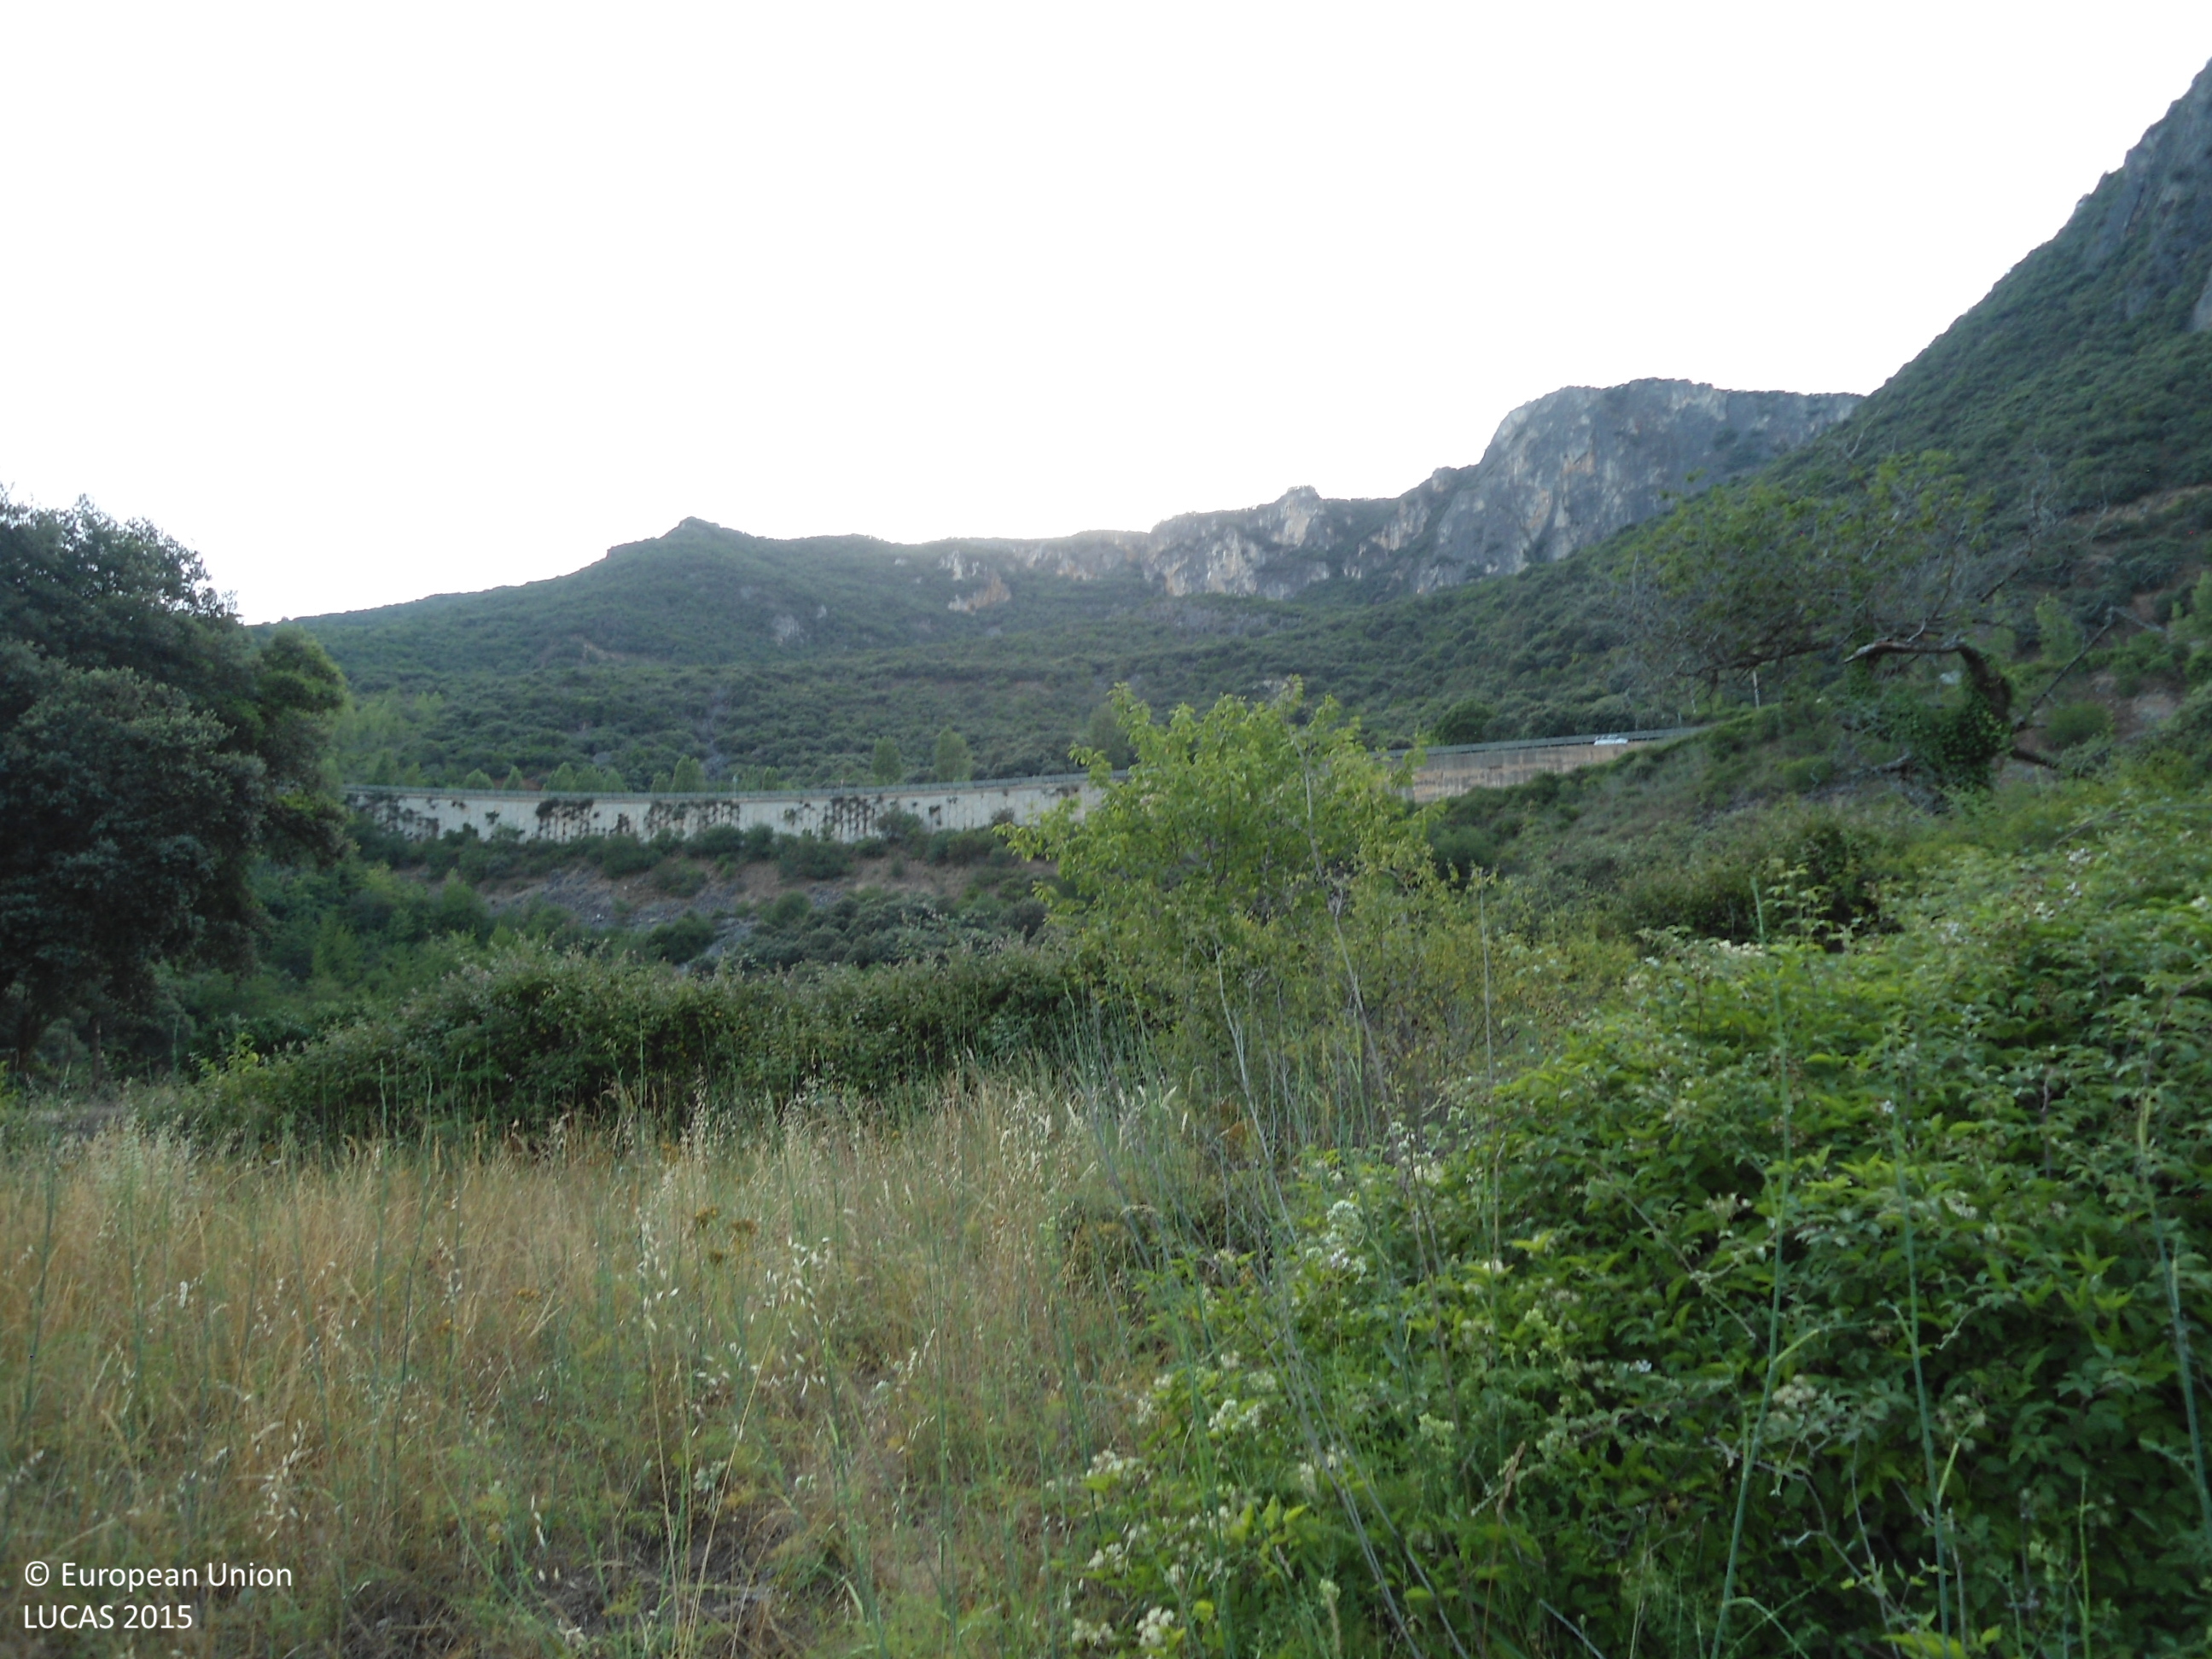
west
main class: Woodland
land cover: Broadleaved woodland
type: thermophilous deciduous forest
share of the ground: > 75 %
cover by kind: broadleaved forest trees 85 %, shrubs 15 %
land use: Forestry
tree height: < 5 m
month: June
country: ES
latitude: 42.4858
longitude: -6.8281
